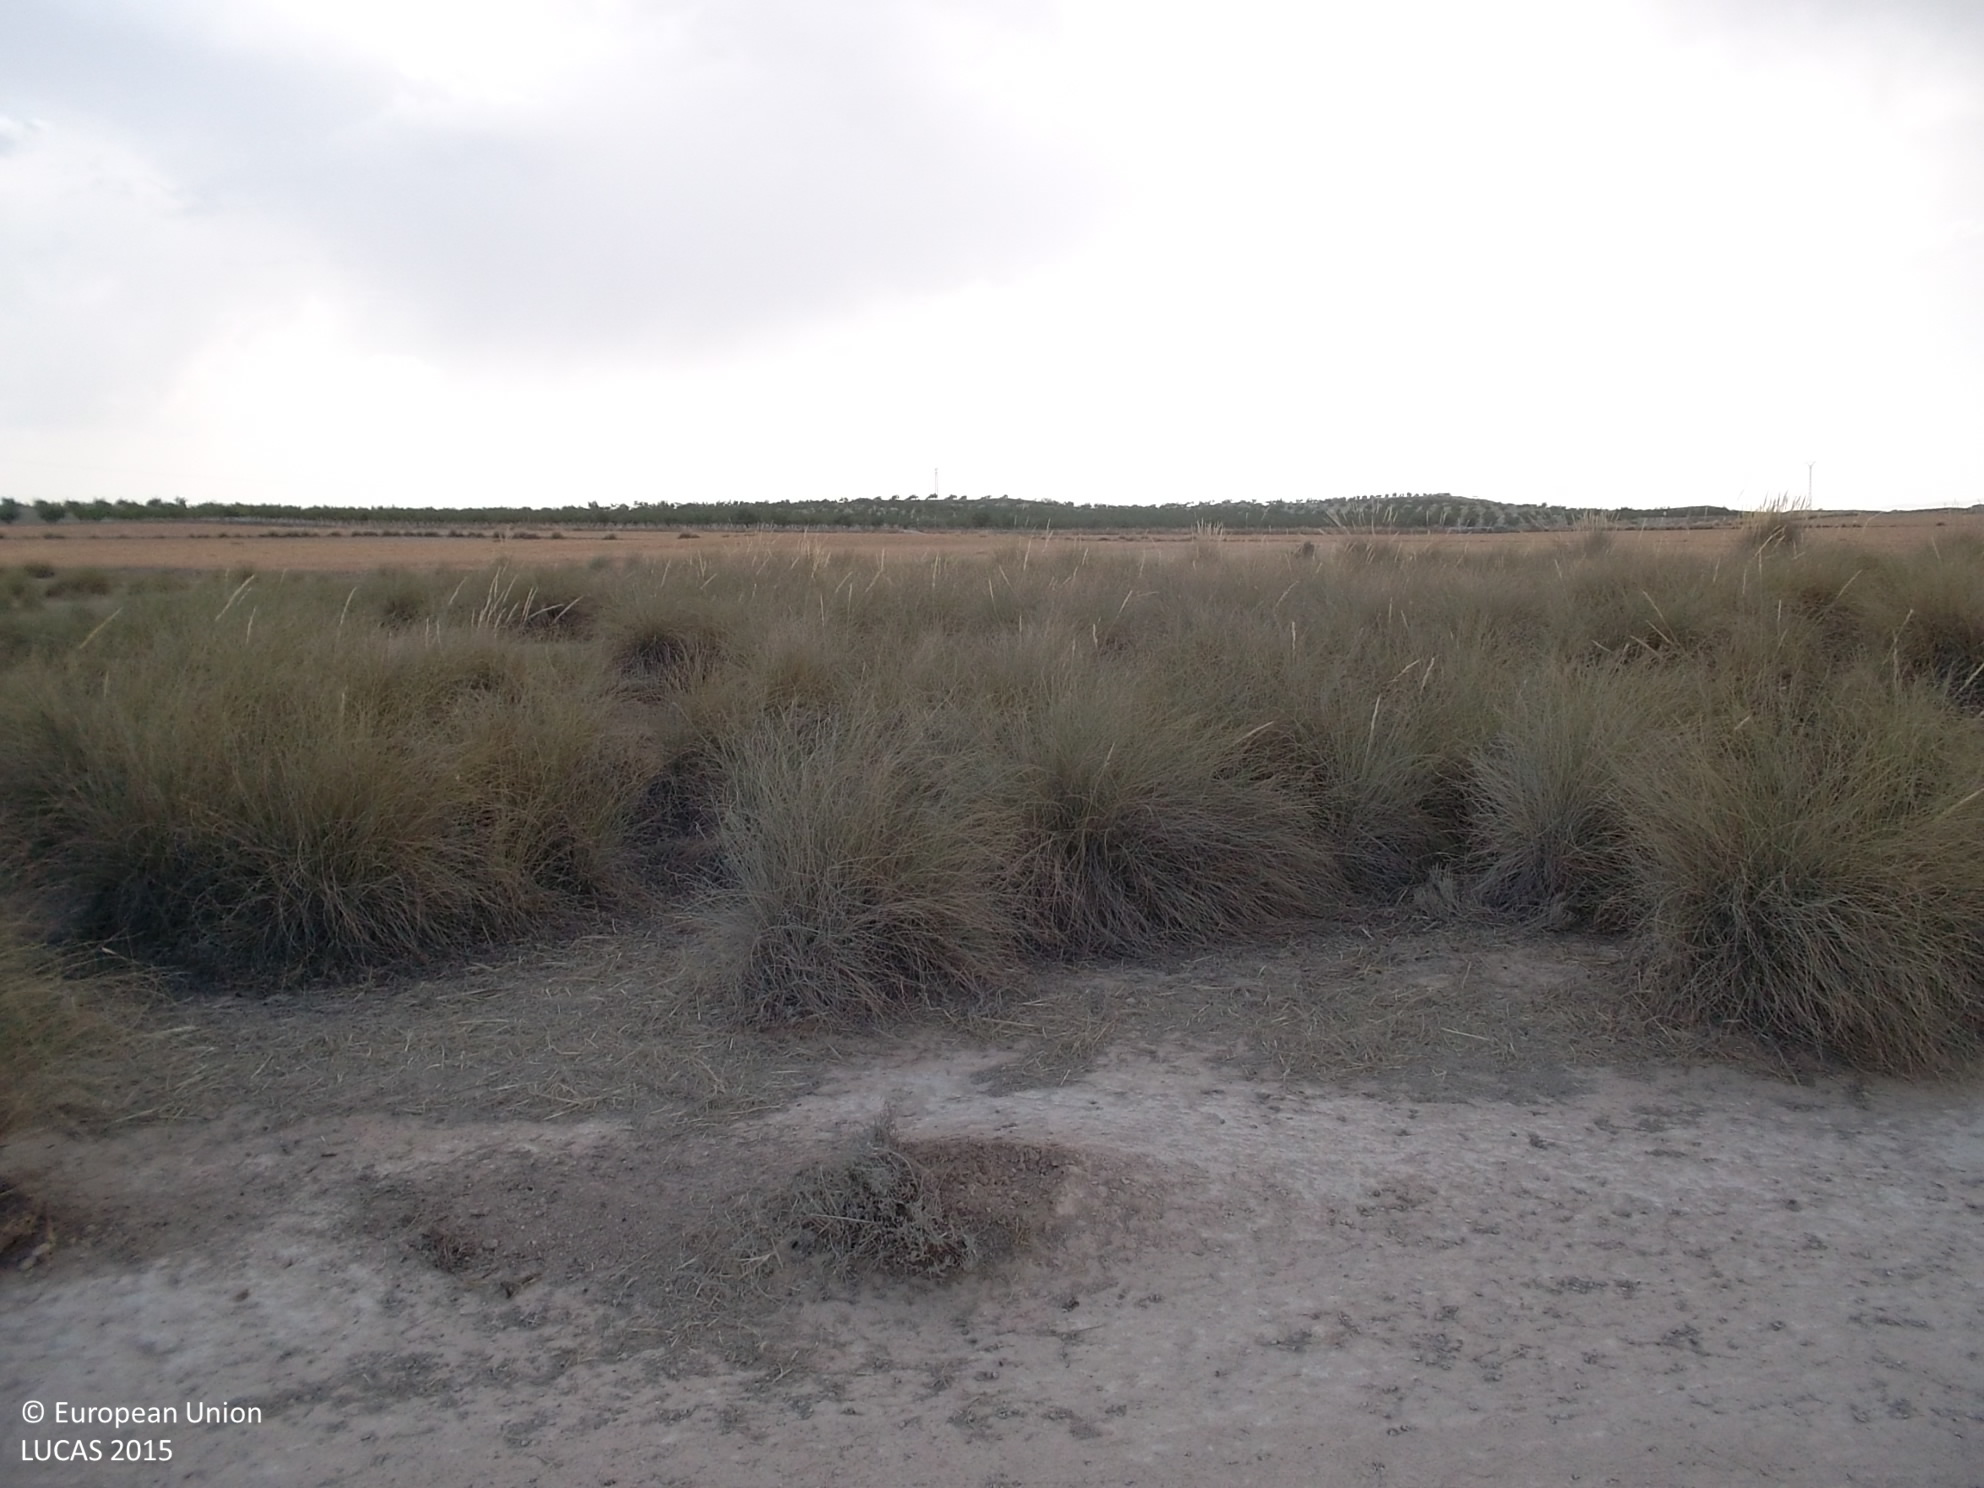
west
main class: Grassland
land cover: Grassland without tree/shrub cover
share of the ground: 50 - 75 %
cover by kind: herbaceous plants 65 %, unconsolidated bare surface 35 %
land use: Agriculture (excluding fallow land and kitchen gardens)
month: July
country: ES
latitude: 37.6776
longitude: -2.7225
